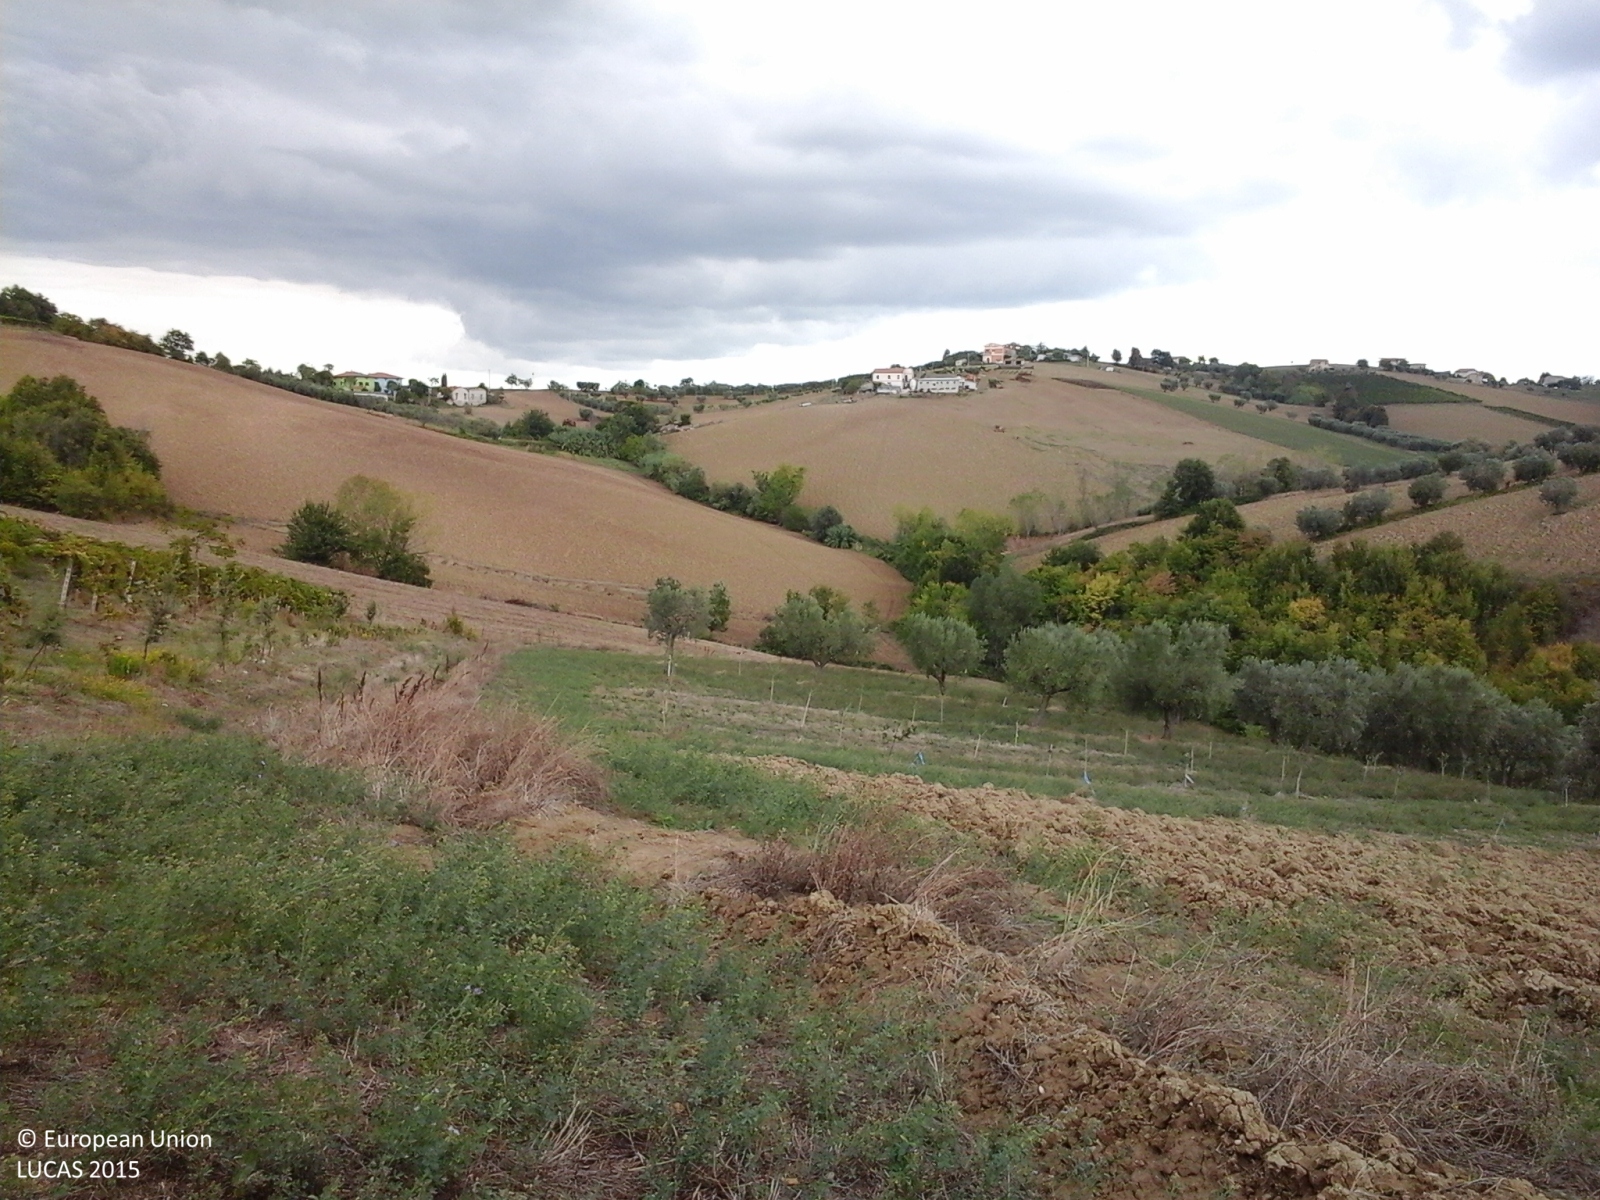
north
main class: Cropland
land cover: Lucerne
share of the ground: > 75 %
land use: Agriculture (excluding fallow land and kitchen gardens)
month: September
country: IT
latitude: 42.8369
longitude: 13.7699
